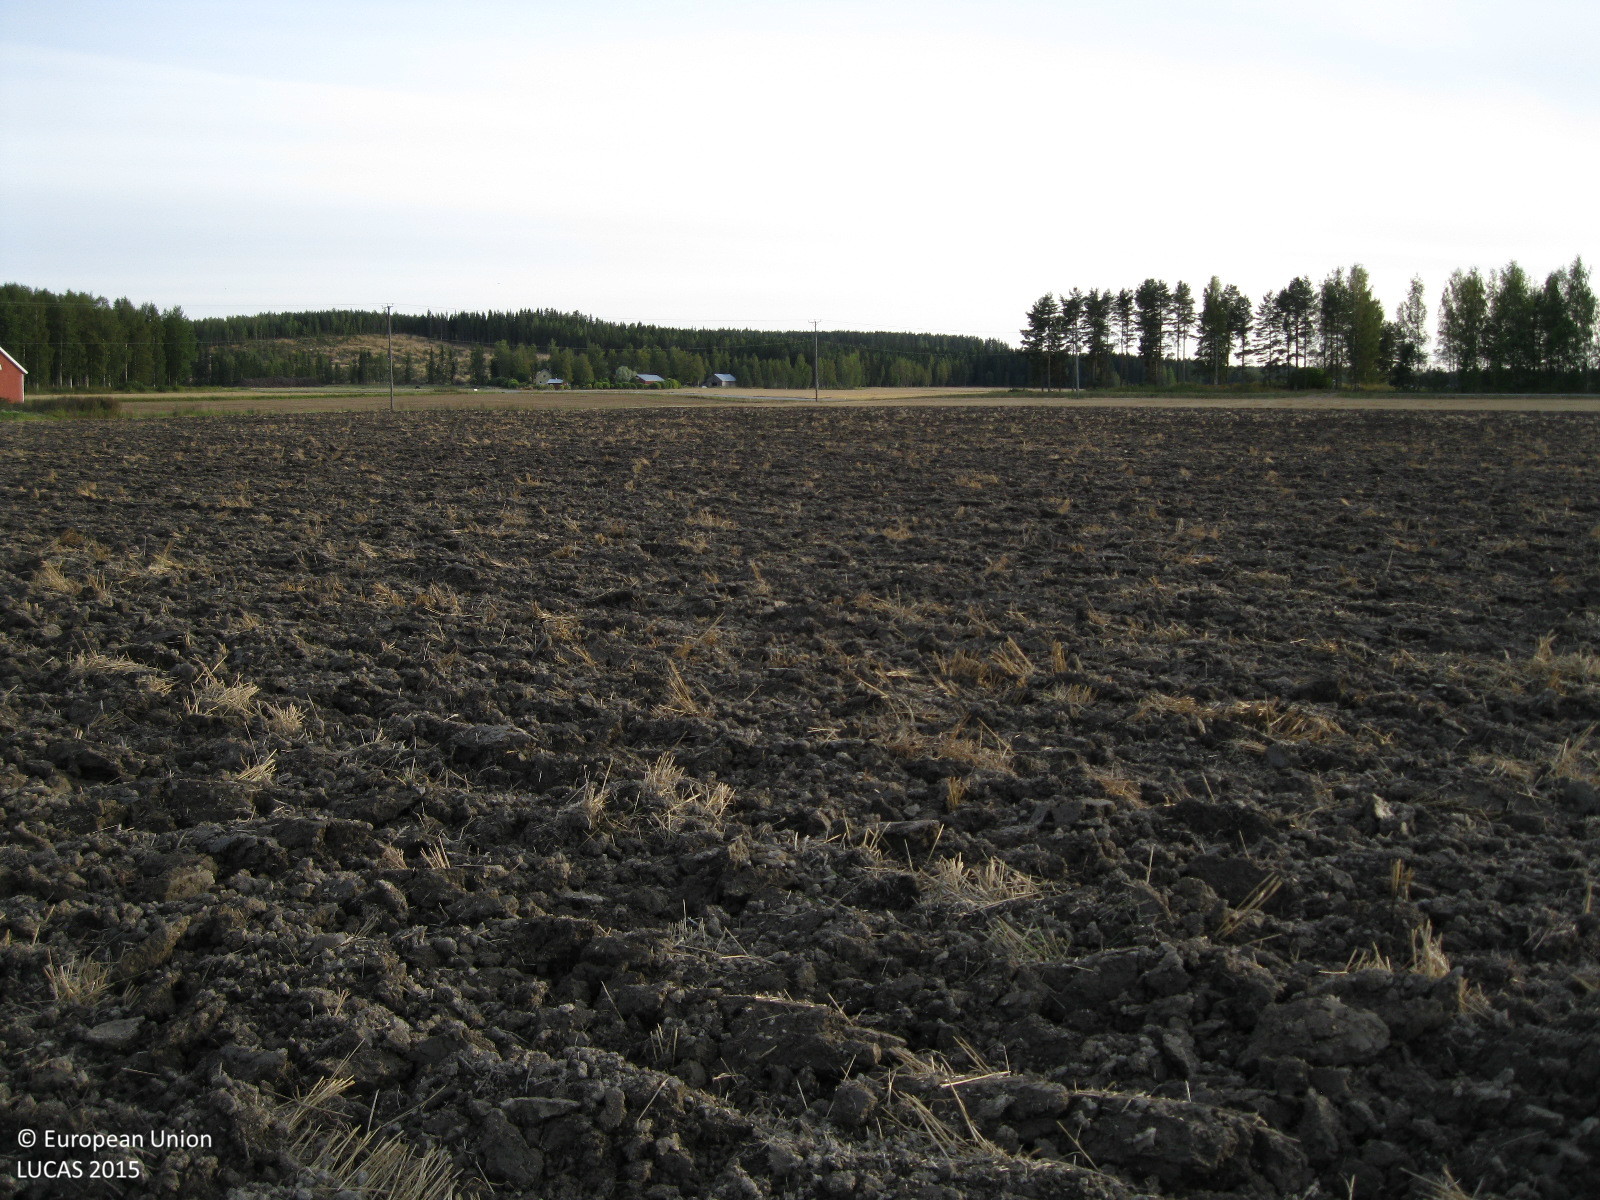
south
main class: Cropland
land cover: Common wheat
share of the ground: > 75 %
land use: Agriculture (excluding fallow land and kitchen gardens)
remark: Harvested field
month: September
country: FI
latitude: 60.5768
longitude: 24.7279
